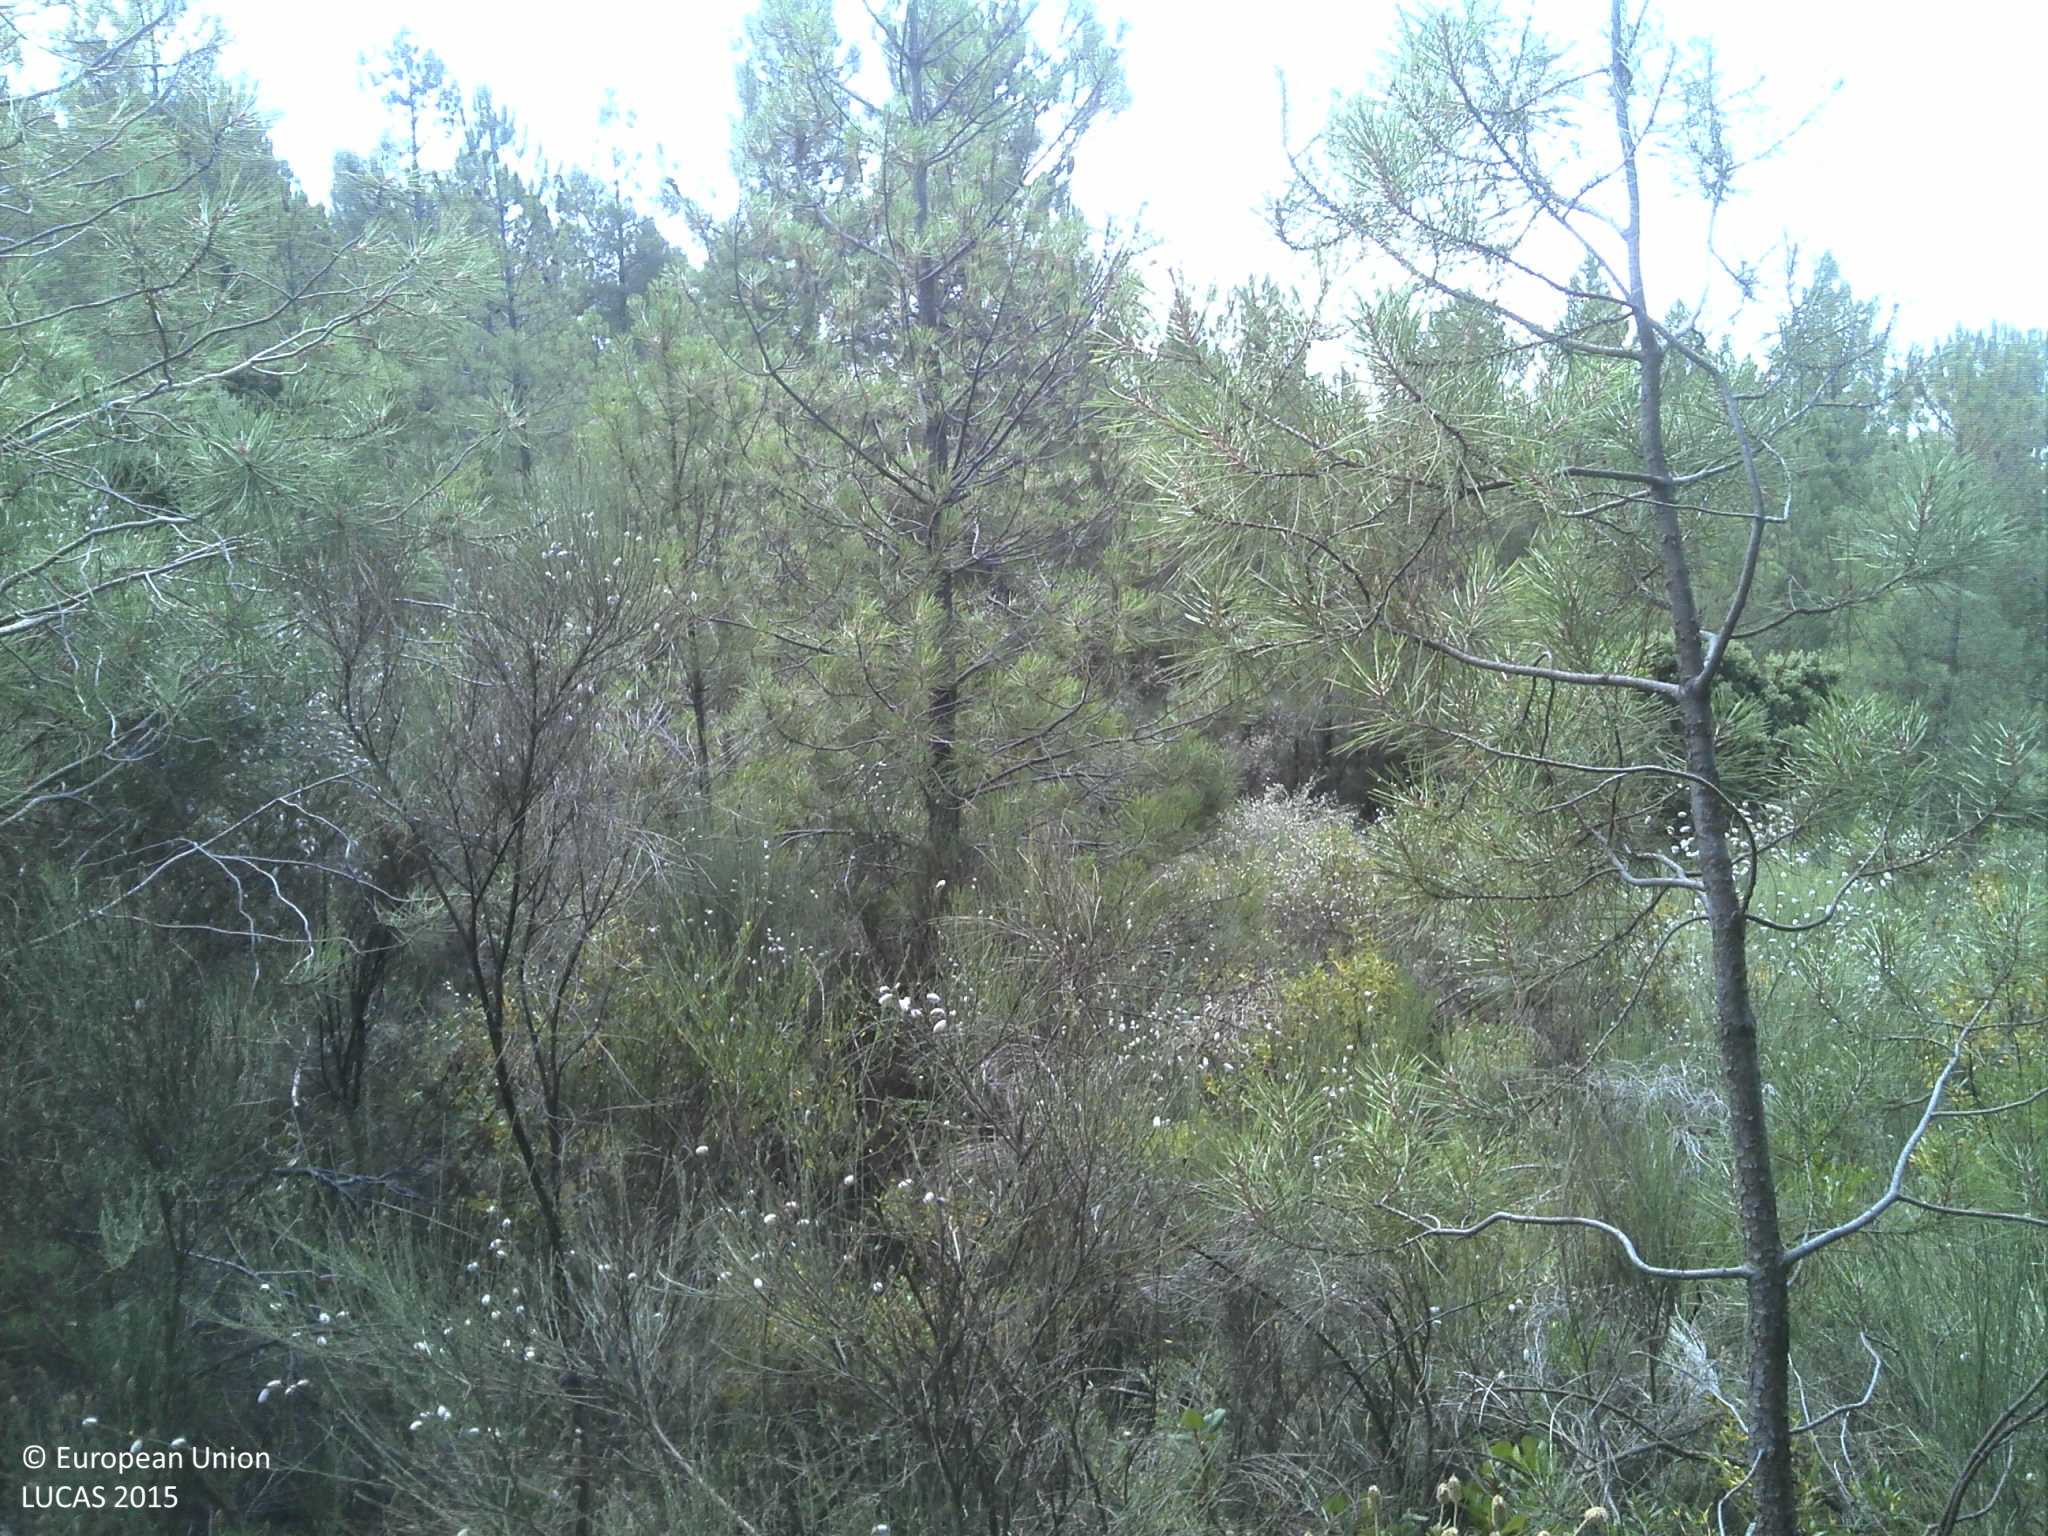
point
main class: Woodland
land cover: Pine dominated coniferous woodland
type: coniferous forest of the mediterranean region
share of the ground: 25 - 50 %
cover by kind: coniferous forest trees 45 %, shrubs 35 %, unconsolidated bare surface 20 %
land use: Forestry
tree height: > 5 m
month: June
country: PT
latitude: 40.1986
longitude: -7.1666
